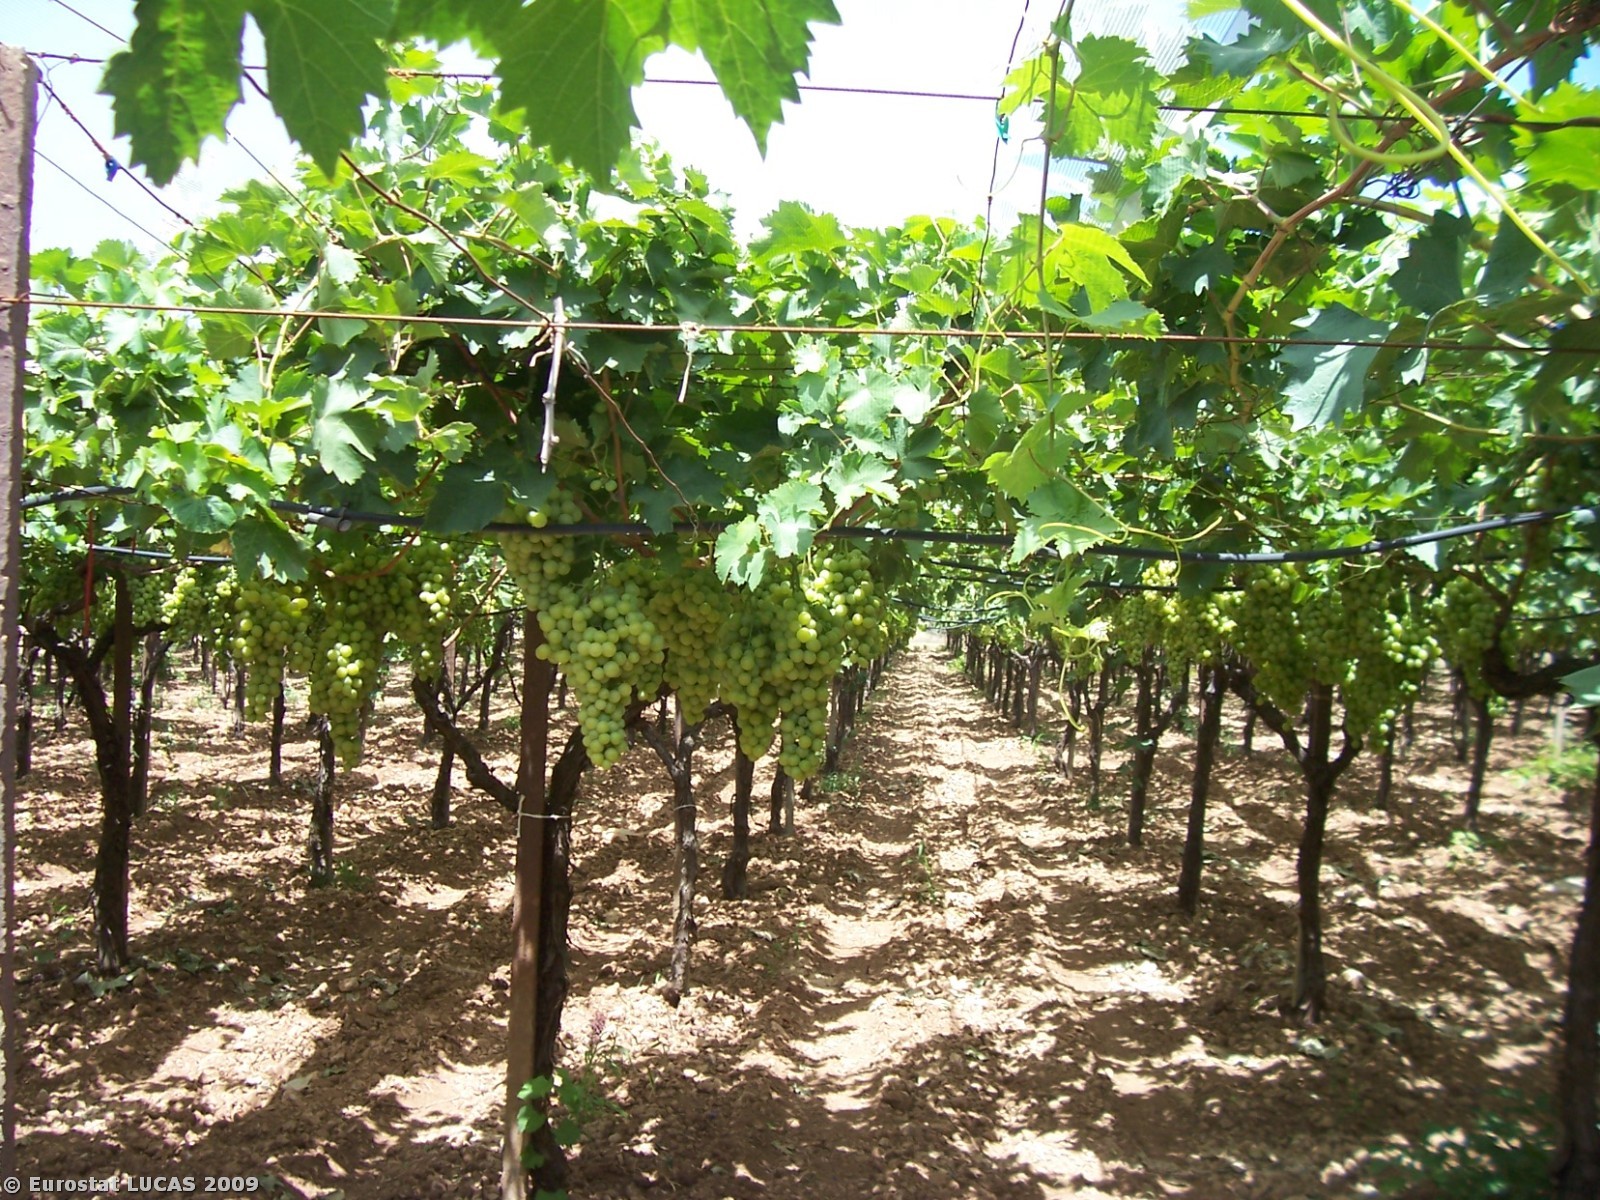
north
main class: Cropland
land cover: Vineyards
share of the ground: > 75 %
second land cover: Bare land
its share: > 75 %
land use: Agriculture (excluding fallow land and kitchen gardens)
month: July
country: IT
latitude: 40.6155
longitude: 17.0094
